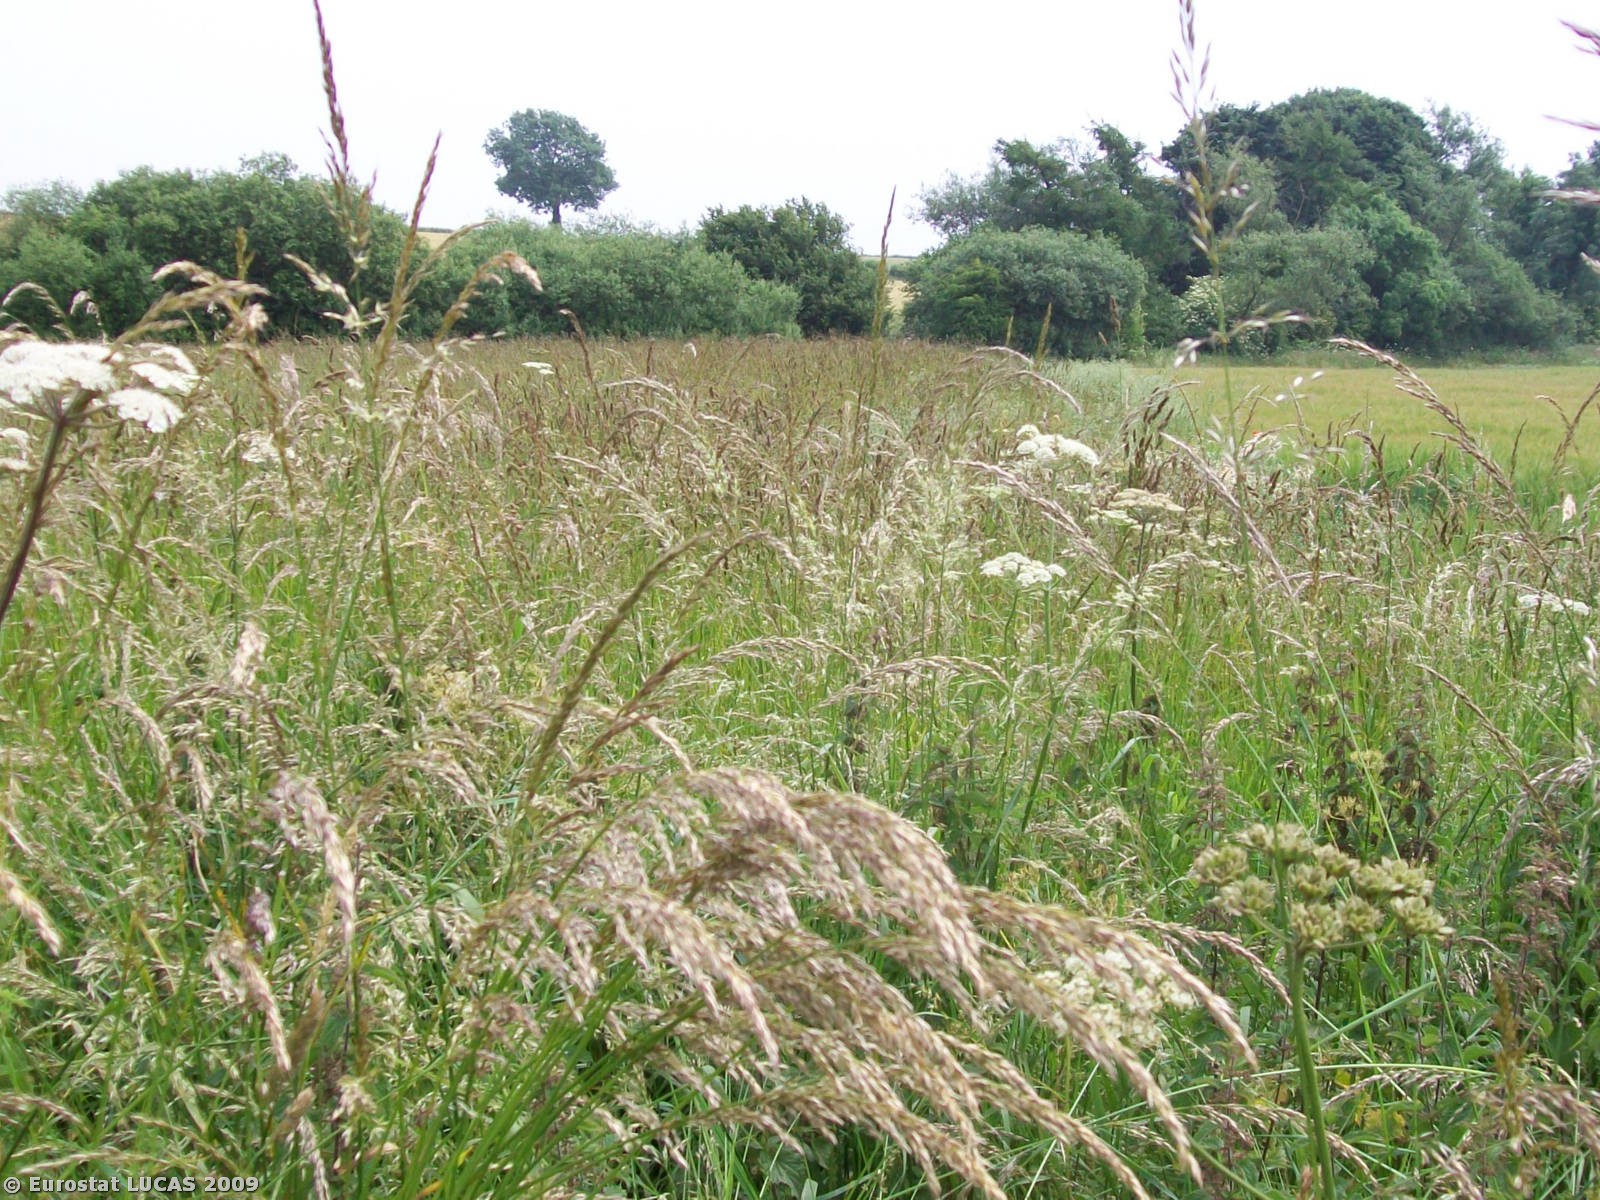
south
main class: Artificial land
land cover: Non built-up linear features
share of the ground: > 75 %
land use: Road transport
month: June
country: GB
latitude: 54.0549
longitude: -1.4597
